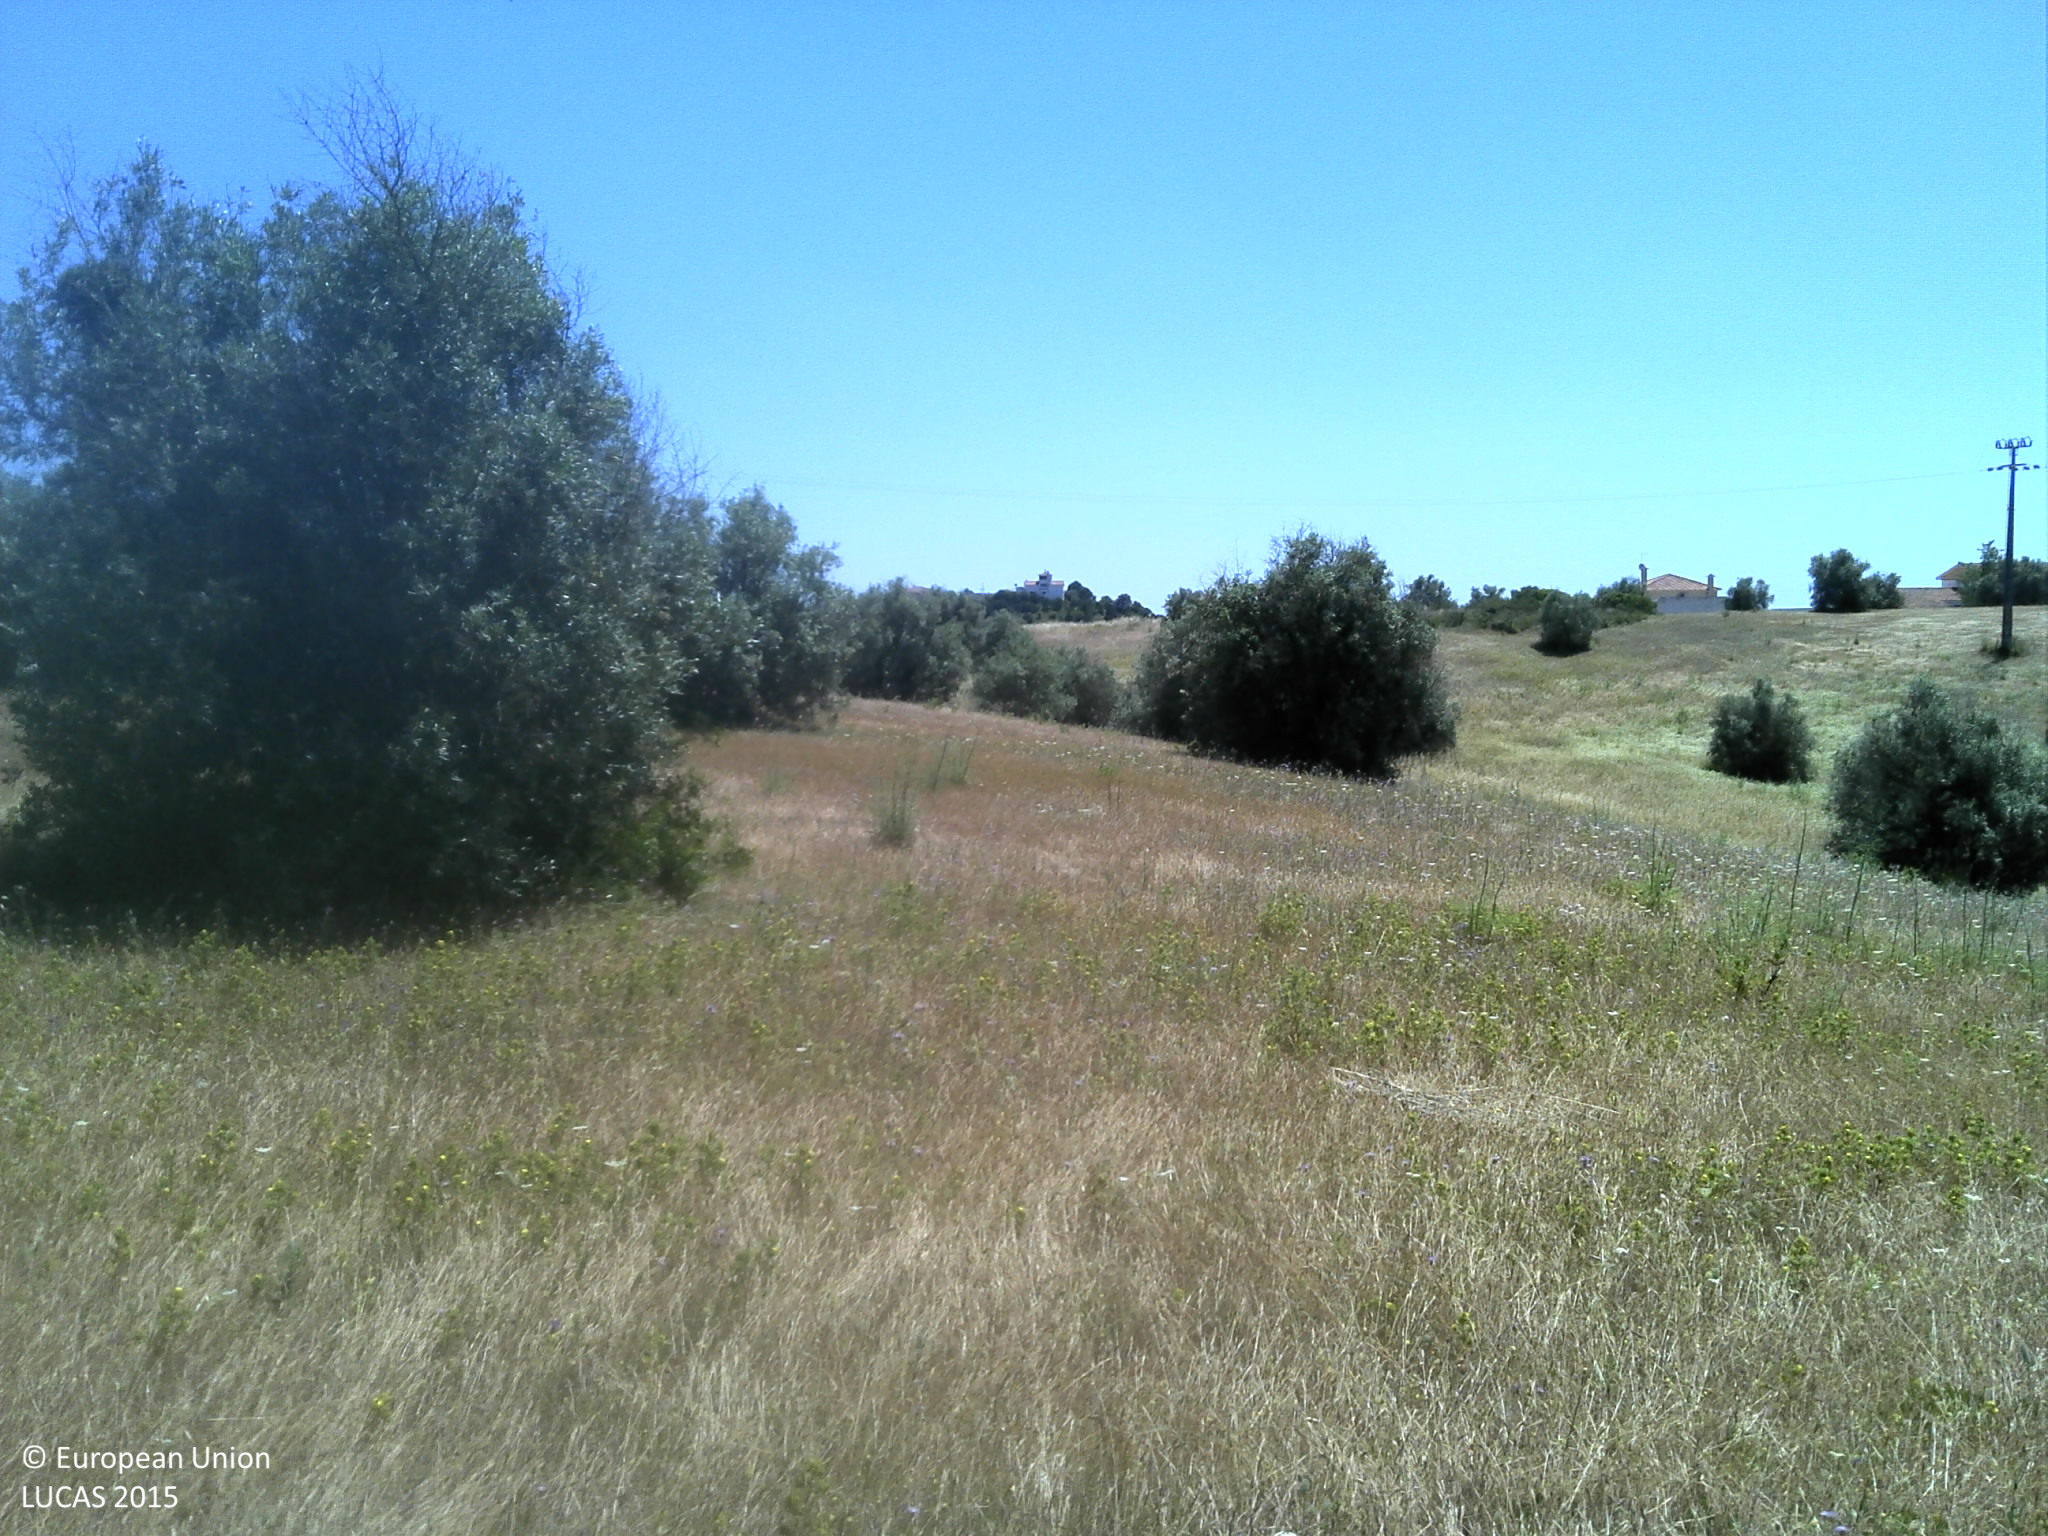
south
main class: Cropland
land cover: Olive groves
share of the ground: 10 - 25 %
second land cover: Grassland without tree/shrub cover
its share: 50 - 75 %
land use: Agriculture (excluding fallow land and kitchen gardens)
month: May
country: PT
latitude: 39.2876
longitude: -8.7769
